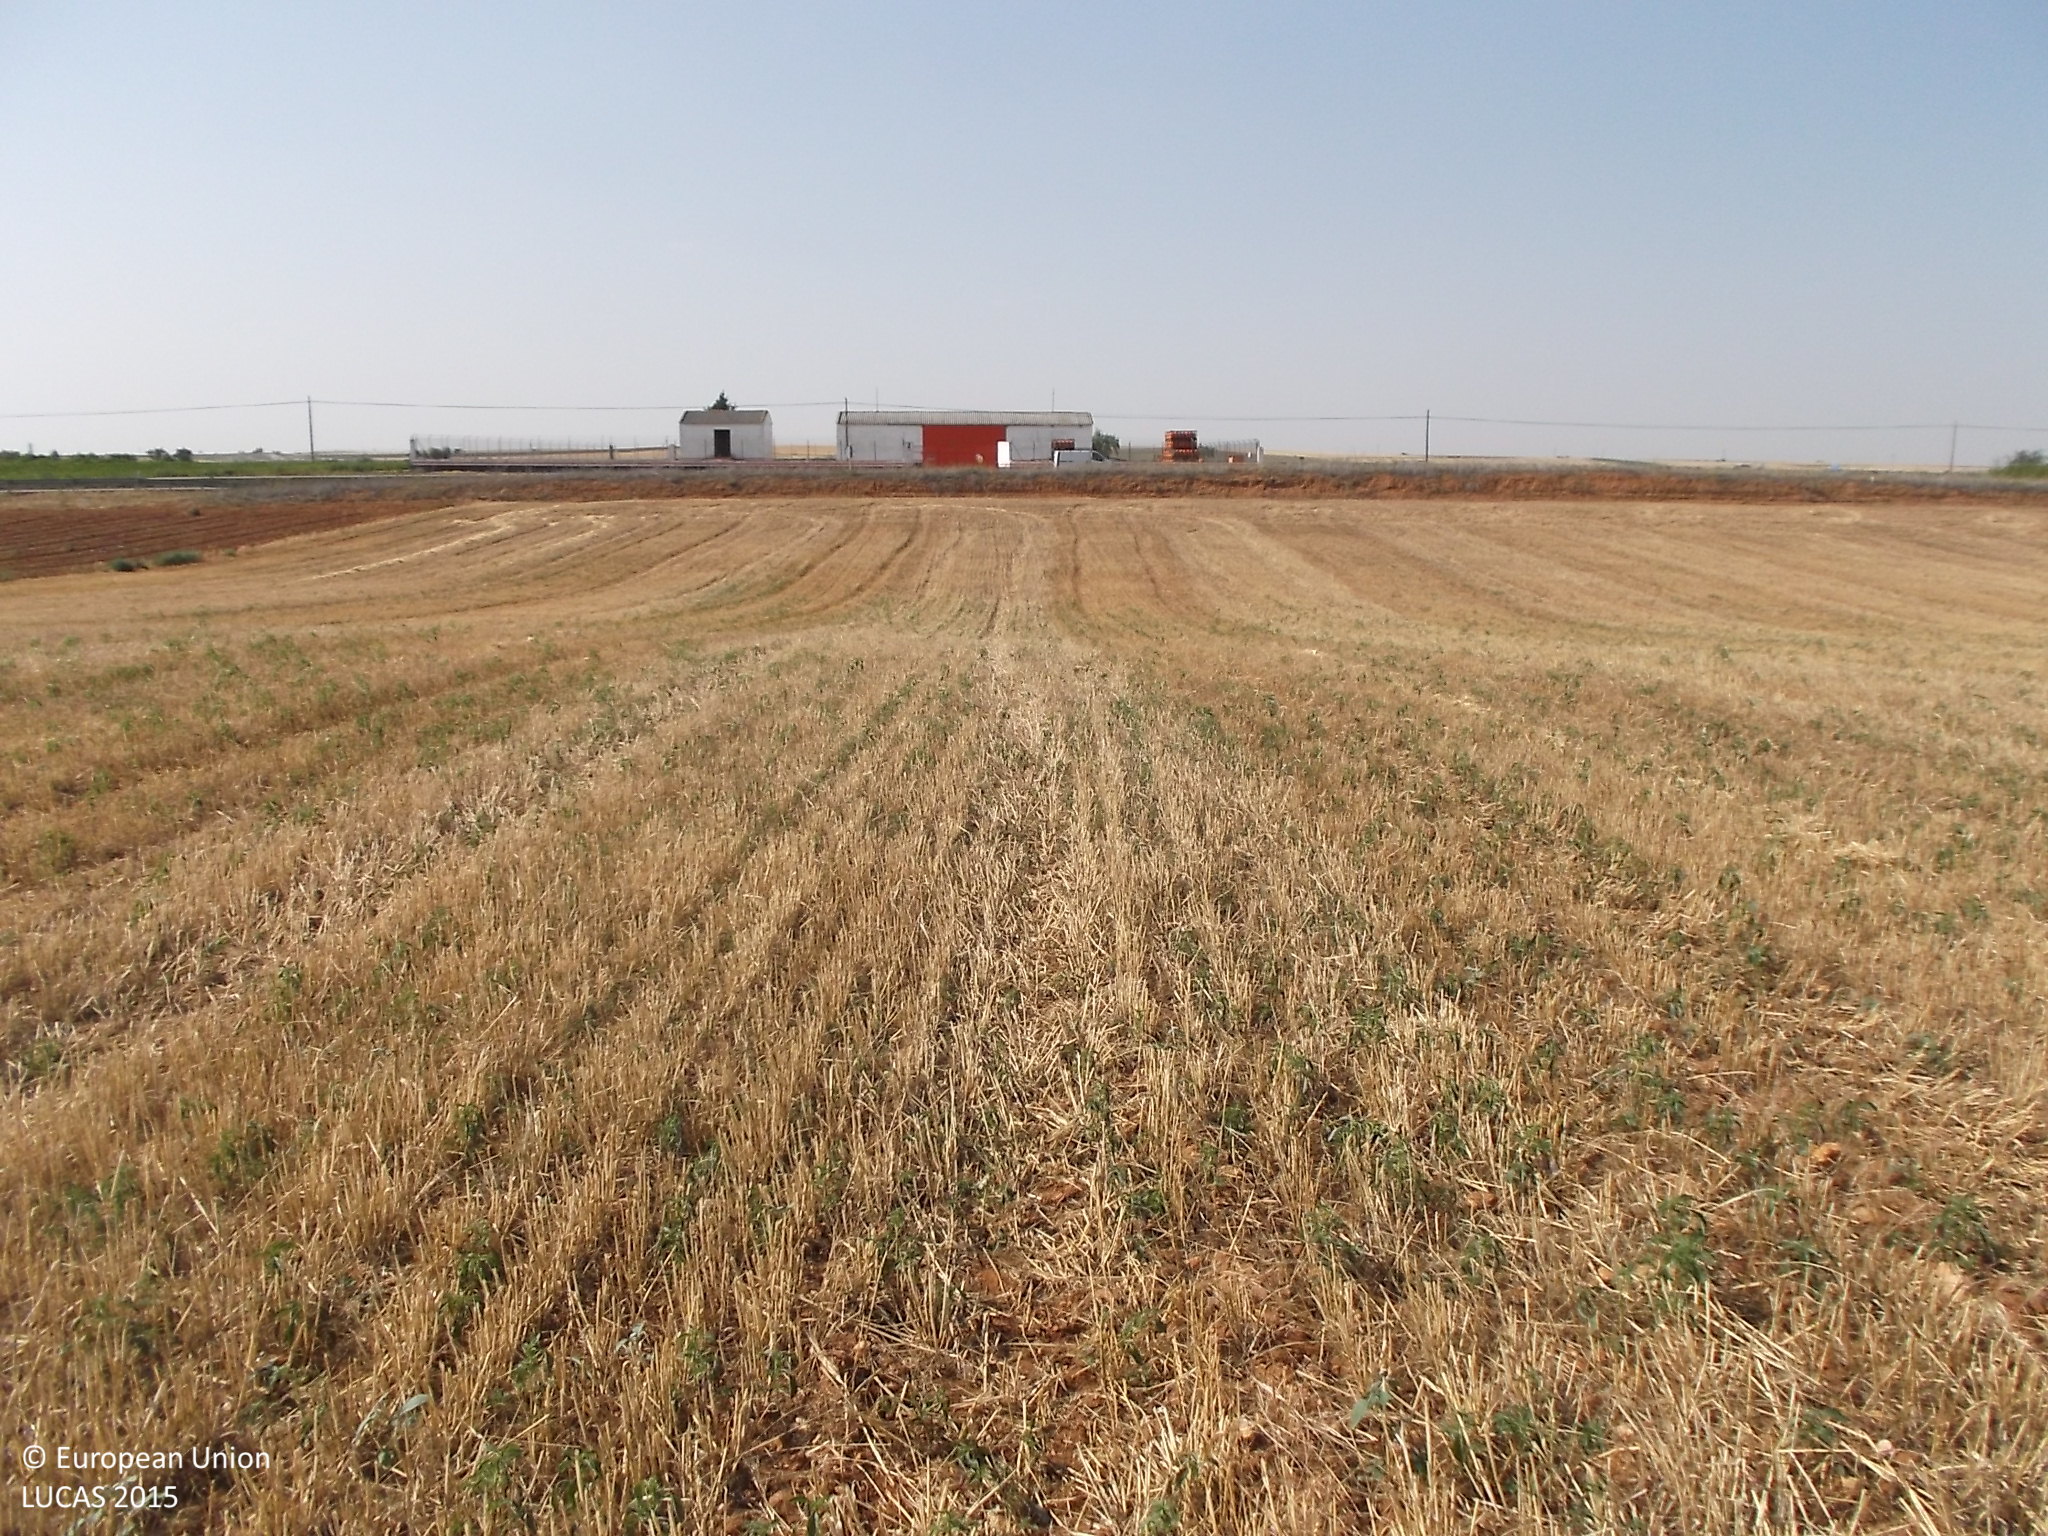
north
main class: Cropland
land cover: Barley
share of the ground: < 10 %
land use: Agriculture (excluding fallow land and kitchen gardens)
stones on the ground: < 10 %
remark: Harvested field
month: July
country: ES
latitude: 41.5294
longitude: -5.3599
